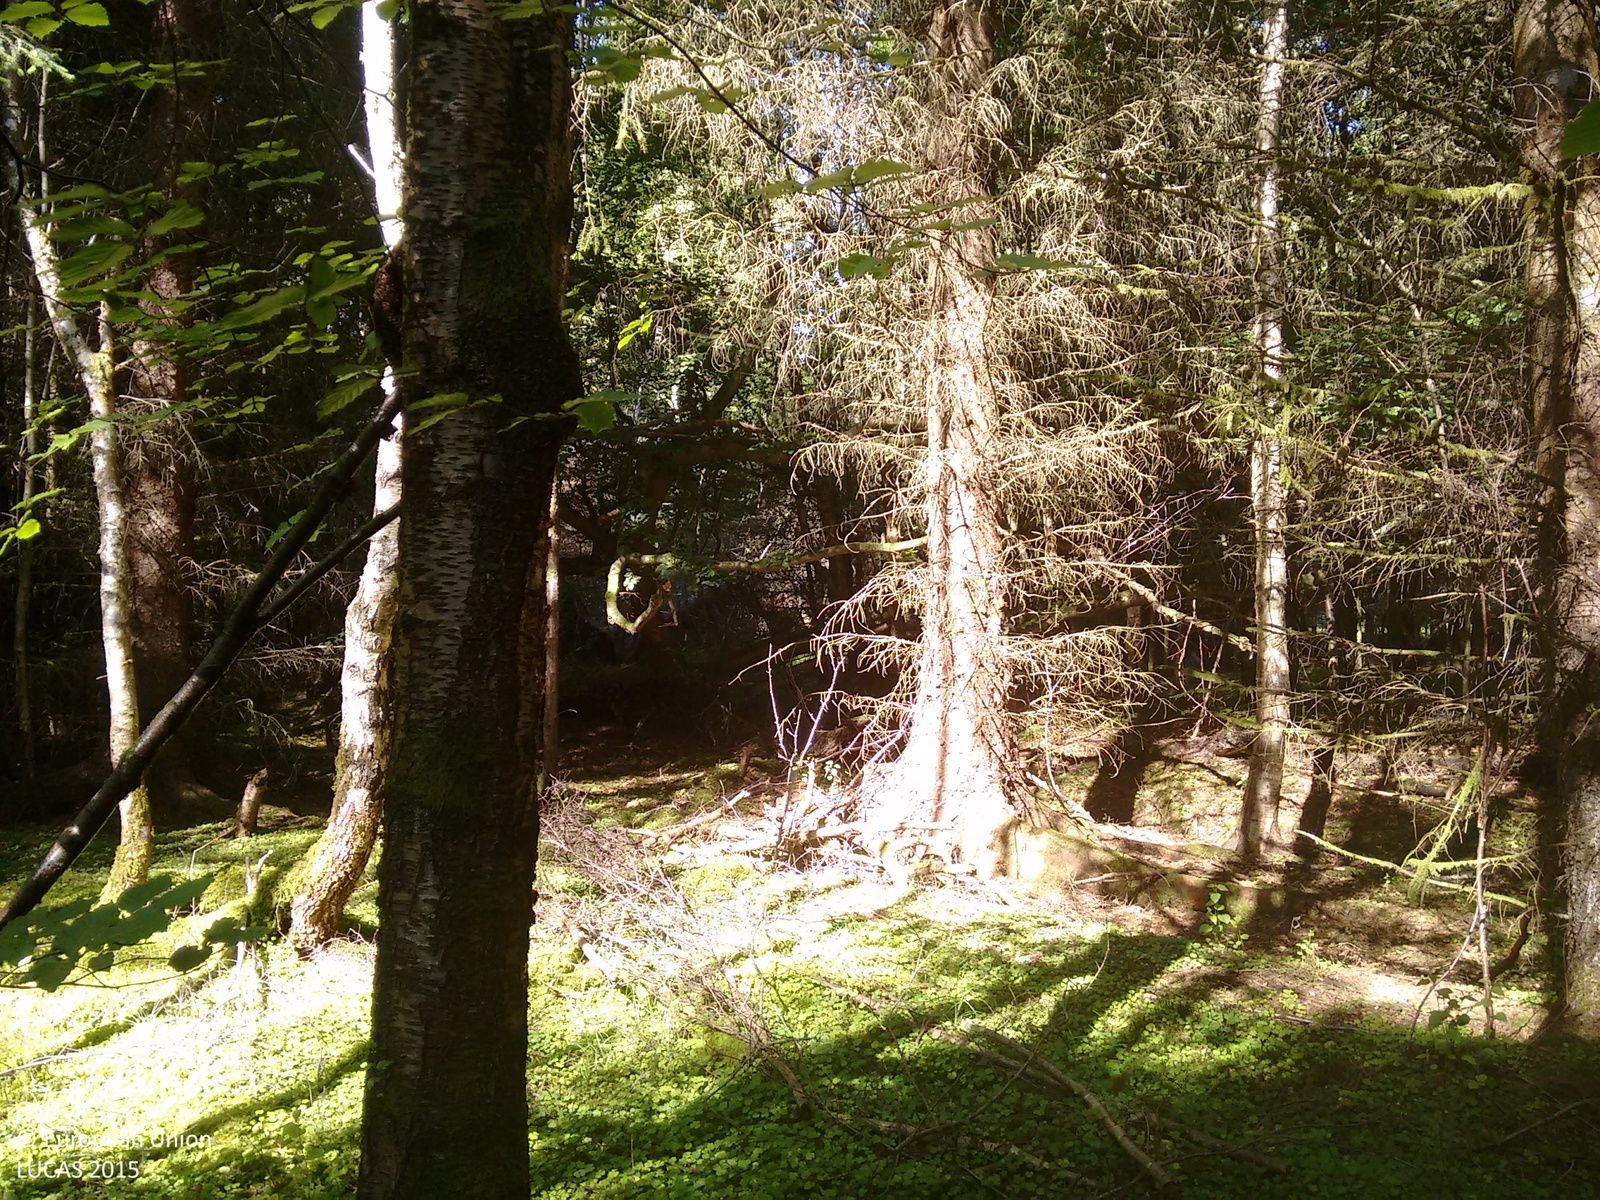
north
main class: Woodland
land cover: Spruce dominated mixed woodland
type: exotic forest
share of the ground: > 75 %
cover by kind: coniferous forest trees 70 %, broadleaved forest trees 30 %
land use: Forestry
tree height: > 5 m
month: August
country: GB
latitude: 57.7515
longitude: -4.0431
